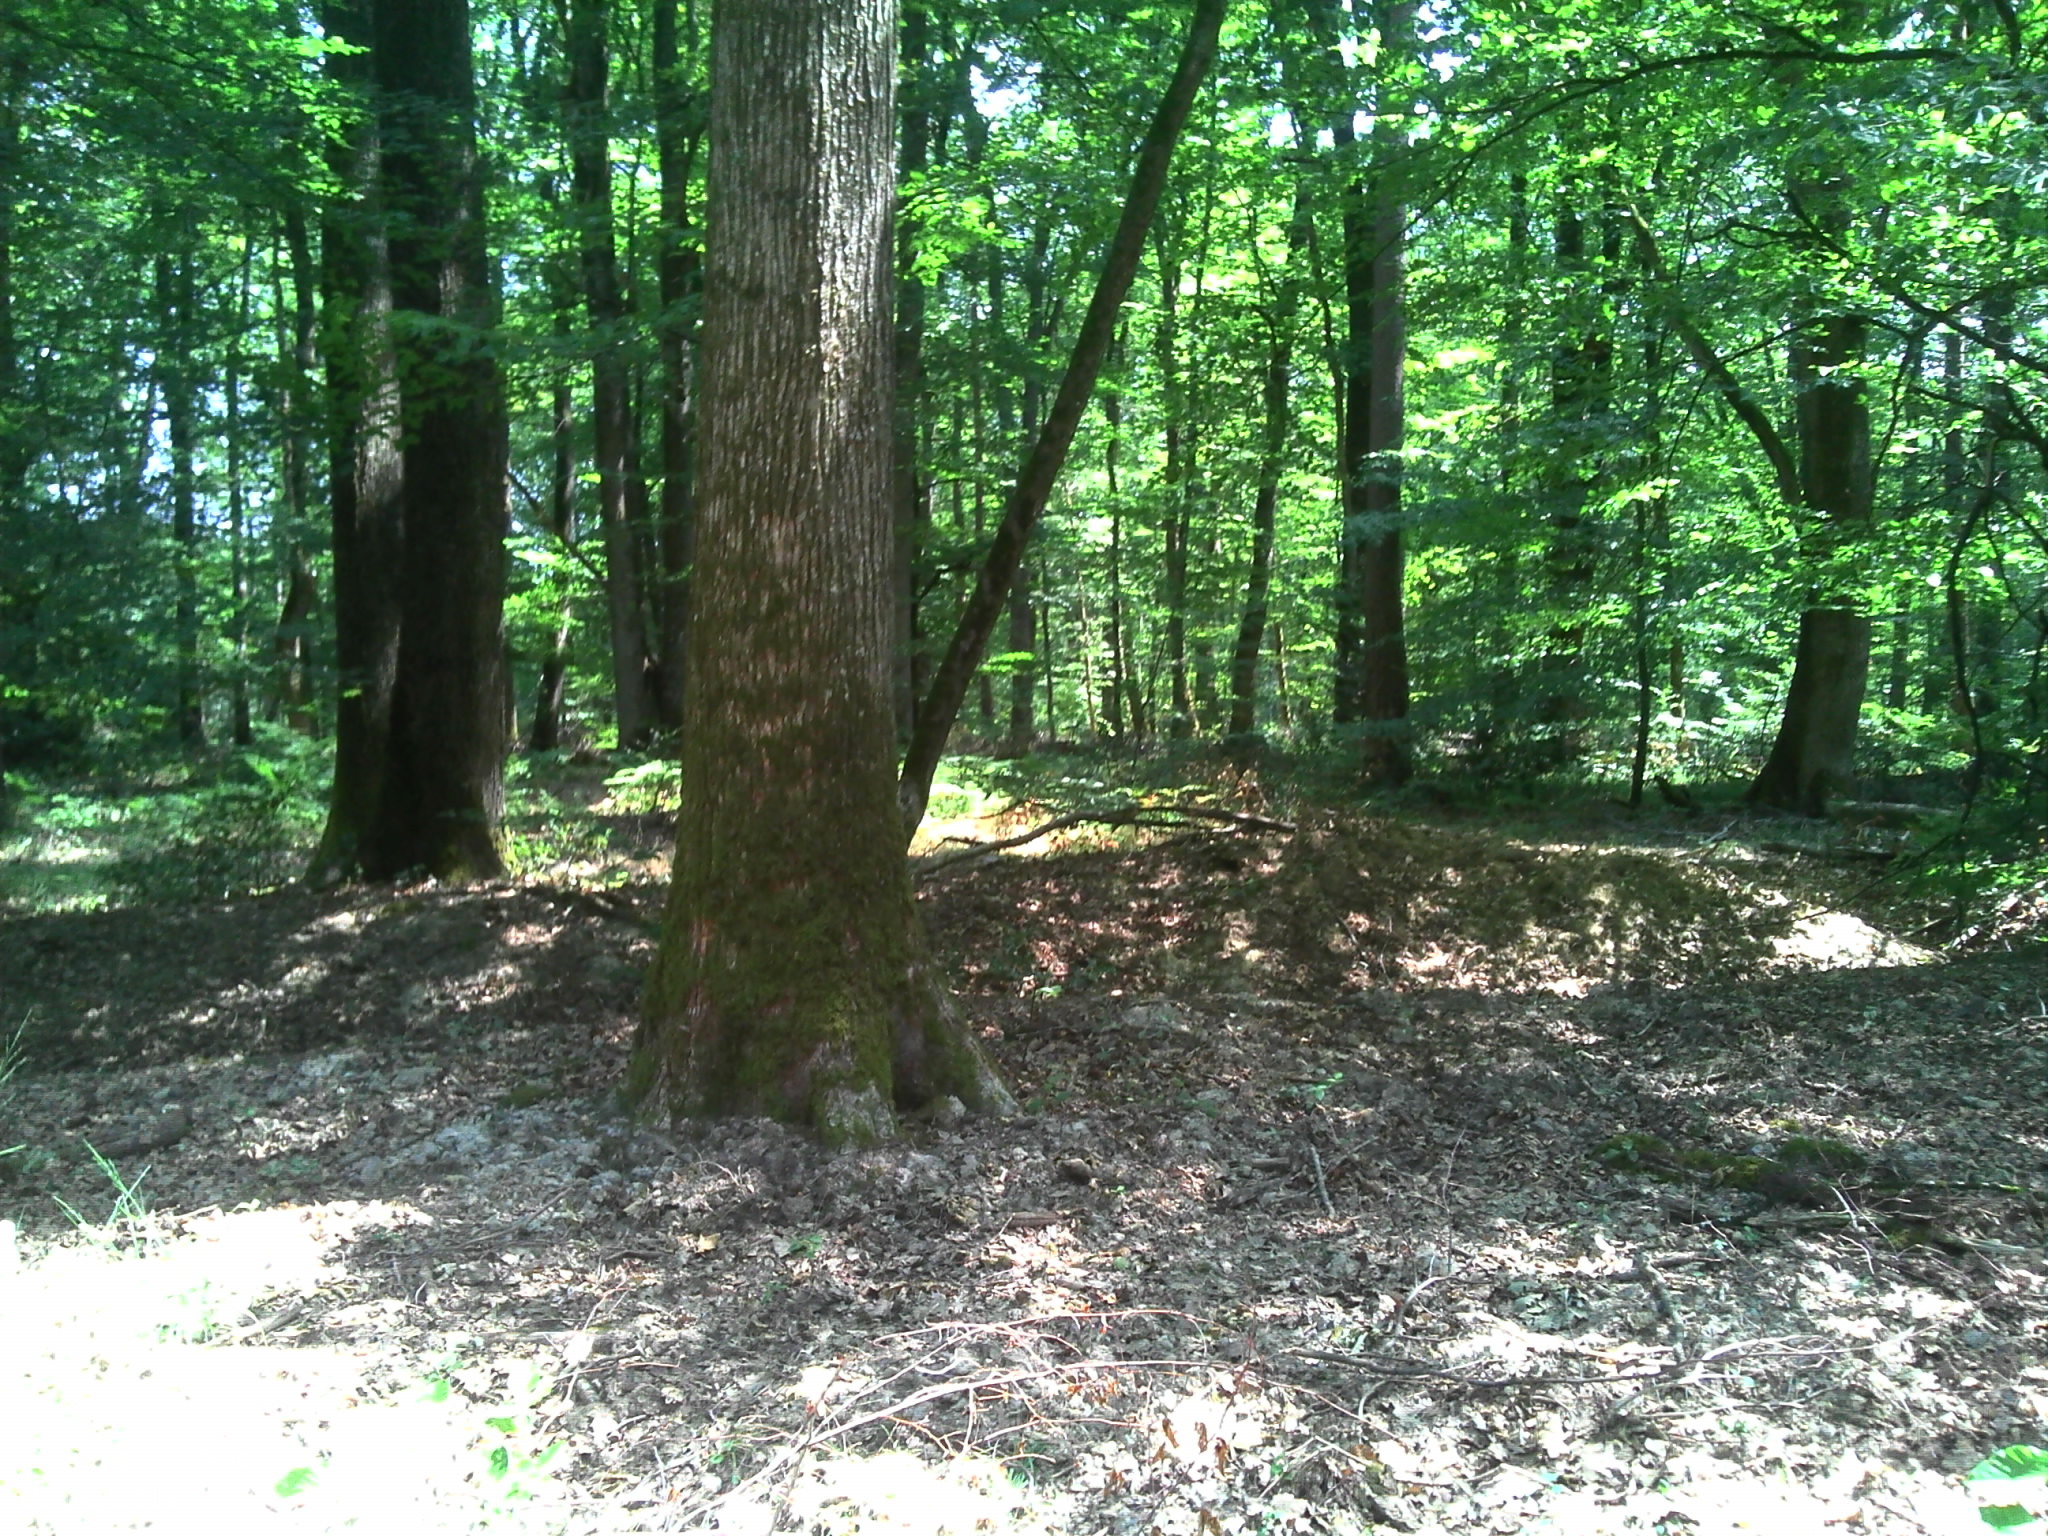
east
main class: Woodland
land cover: Broadleaved woodland
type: mesophytic deciduous forest
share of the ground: > 75 %
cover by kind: broadleaved forest trees 90 %, herbaceous plants 5 %, lichens and mosses 5 %
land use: Forestry
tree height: > 5 m
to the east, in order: Broadleaved woodland; Ditches and canals; Broadleaved woodland; Ditches and canals; Grass margins; Tracks; Grass margins; Ditches and canals; Broadleaved woodland; Ditches and canals; Broadleaved woodland
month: August
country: FR
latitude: 46.6811
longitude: 2.7134
